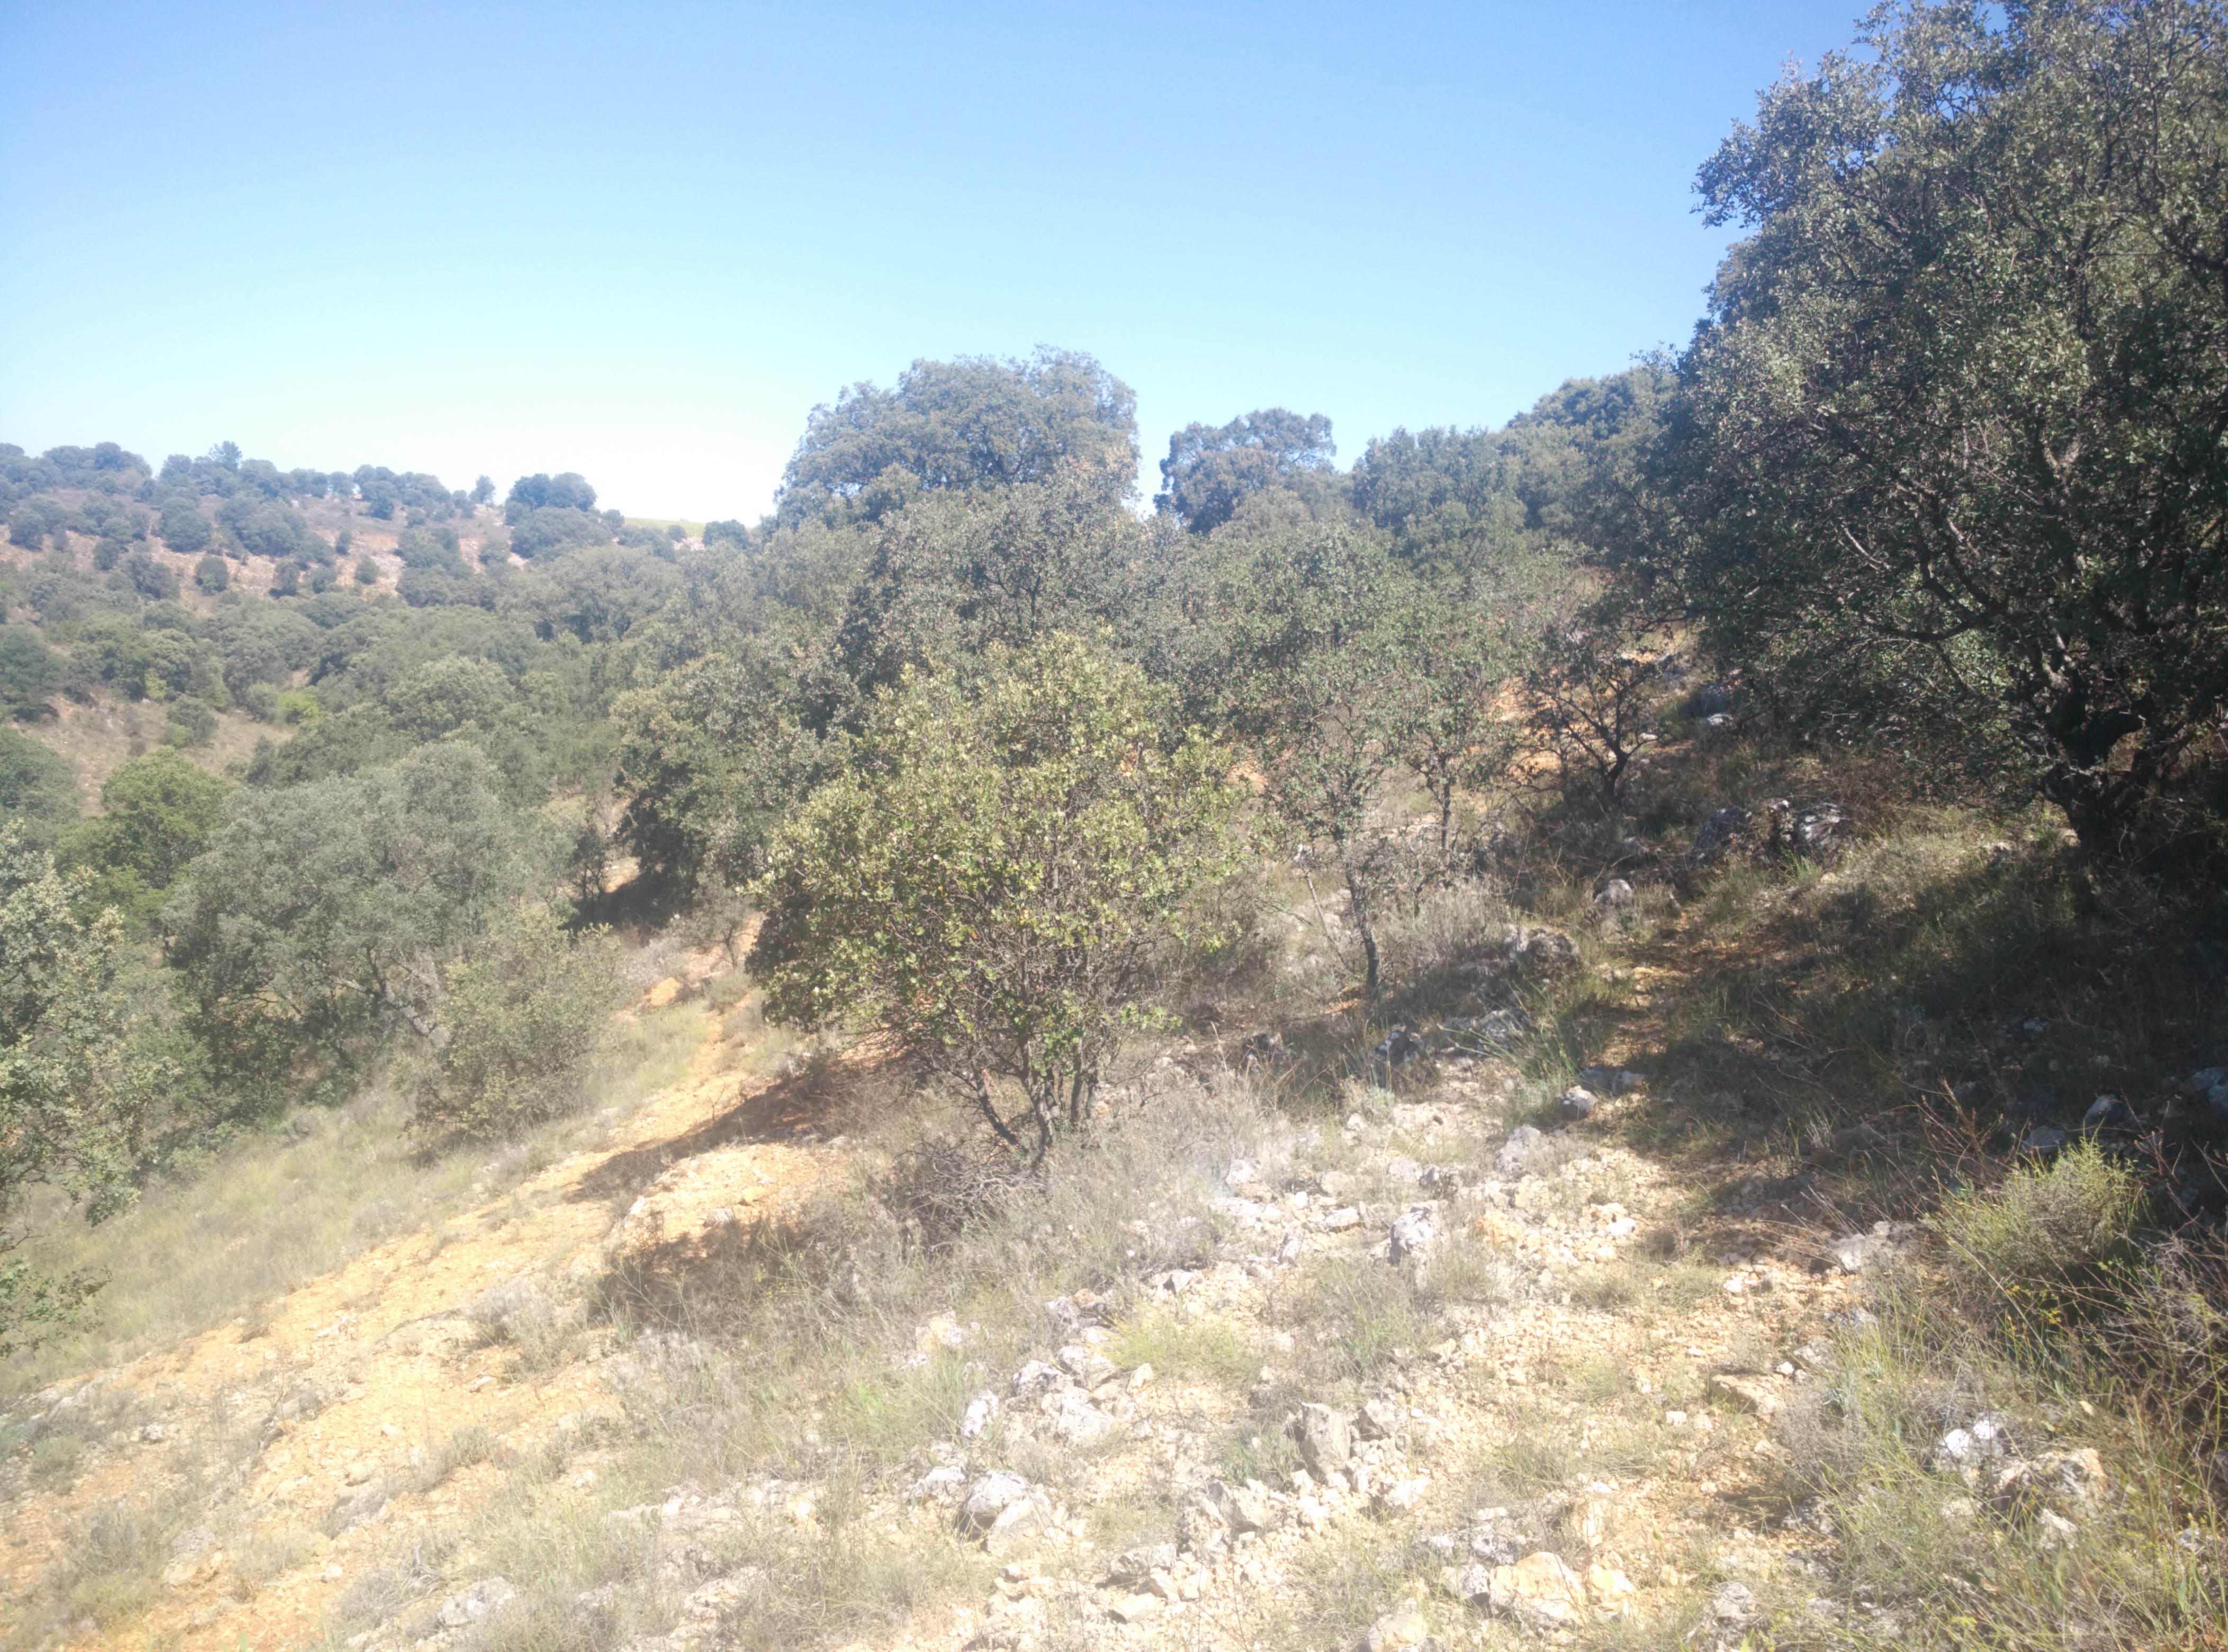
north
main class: Woodland
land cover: Broadleaved woodland
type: thermophilous deciduous forest
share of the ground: 25 - 50 %
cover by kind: broadleaved forest trees 40 %, unconsolidated bare surface 40 %, shrubs 20 %
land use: Semi-natural and natural areas not in use
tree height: > 5 m
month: July
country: ES
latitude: 40.6635
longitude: -2.8403
